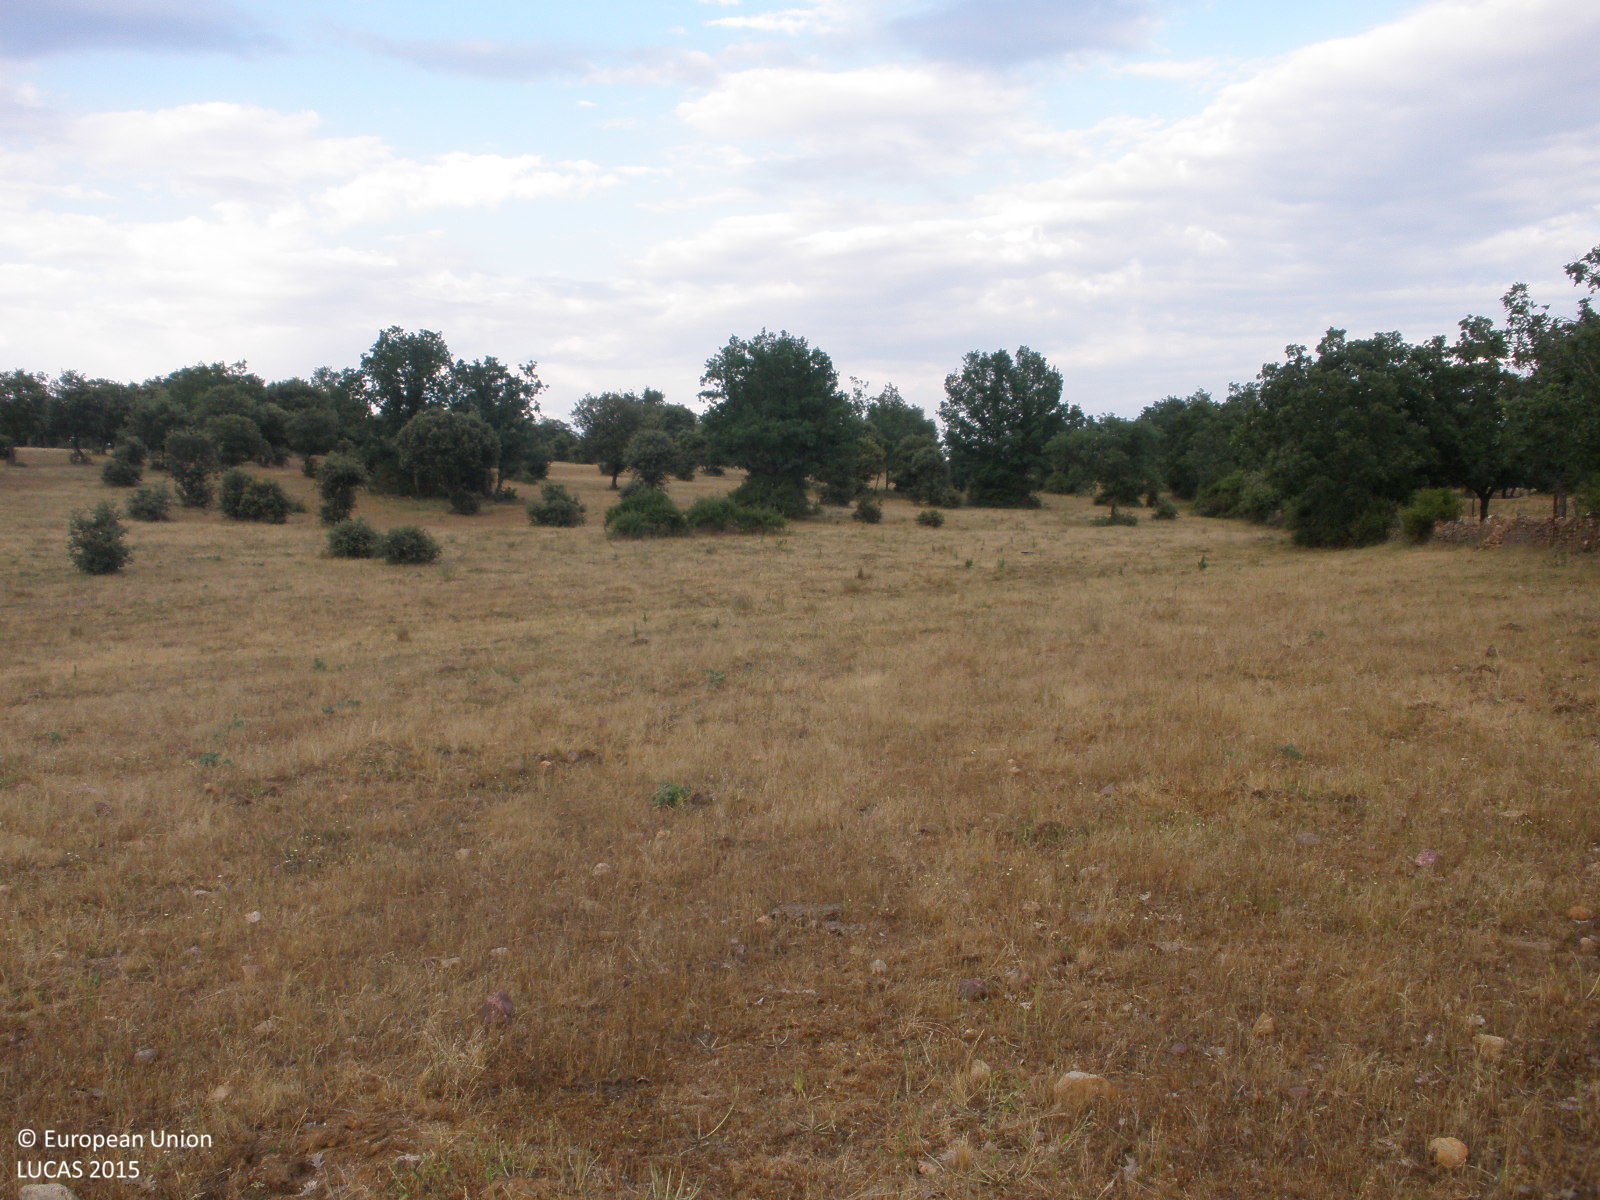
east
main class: Grassland
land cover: Grassland with sparse tree/shrub cover
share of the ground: > 75 %
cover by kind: herbaceous plants 95 %, broadleaved forest trees 5 %
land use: Agriculture (excluding fallow land and kitchen gardens)
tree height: > 5 m
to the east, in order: Grassland with sparse tree/shrub cover; Broadleaved woodland
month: June
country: ES
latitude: 40.6959
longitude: -6.3113
